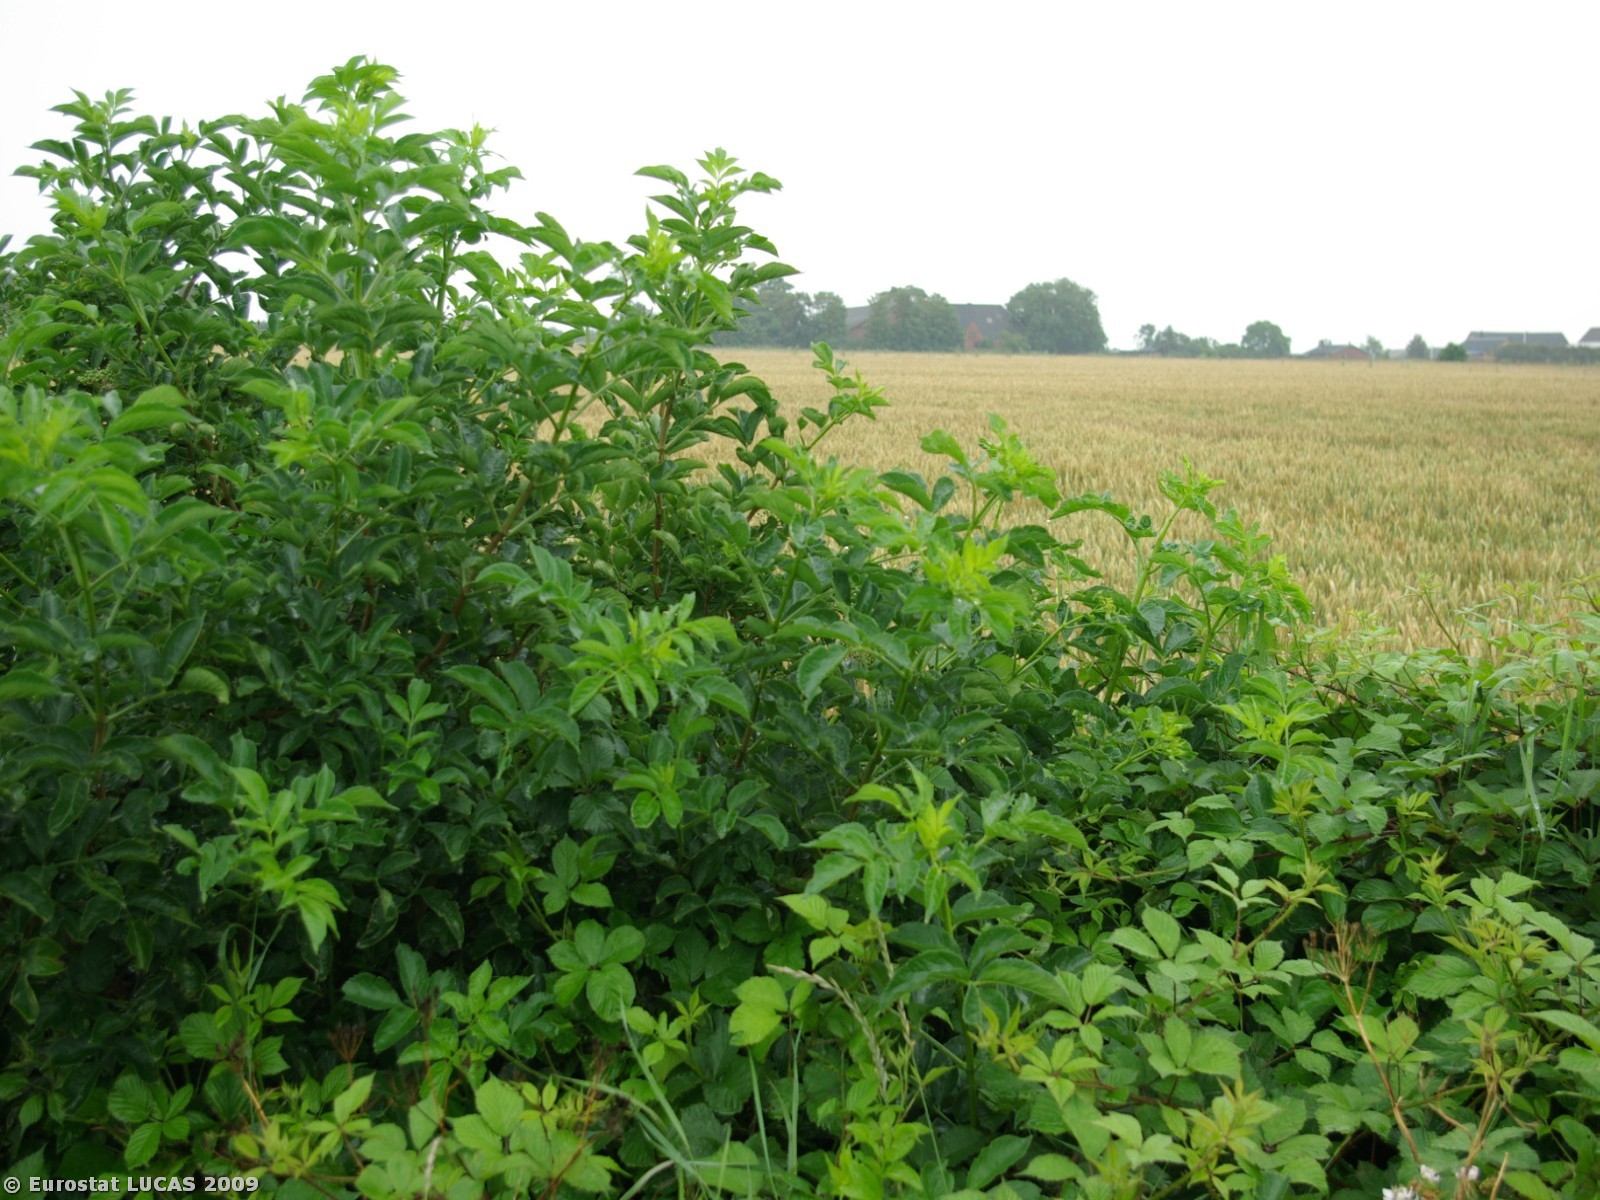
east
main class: Cropland
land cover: Maize
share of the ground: > 75 %
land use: Agriculture (excluding fallow land and kitchen gardens)
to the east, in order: Maize; Grass margins; Fences; Grass margins; Tracks; Spontaneously vegetated surfaces; Common wheat
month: July
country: DK
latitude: 55.2476
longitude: 8.8212
